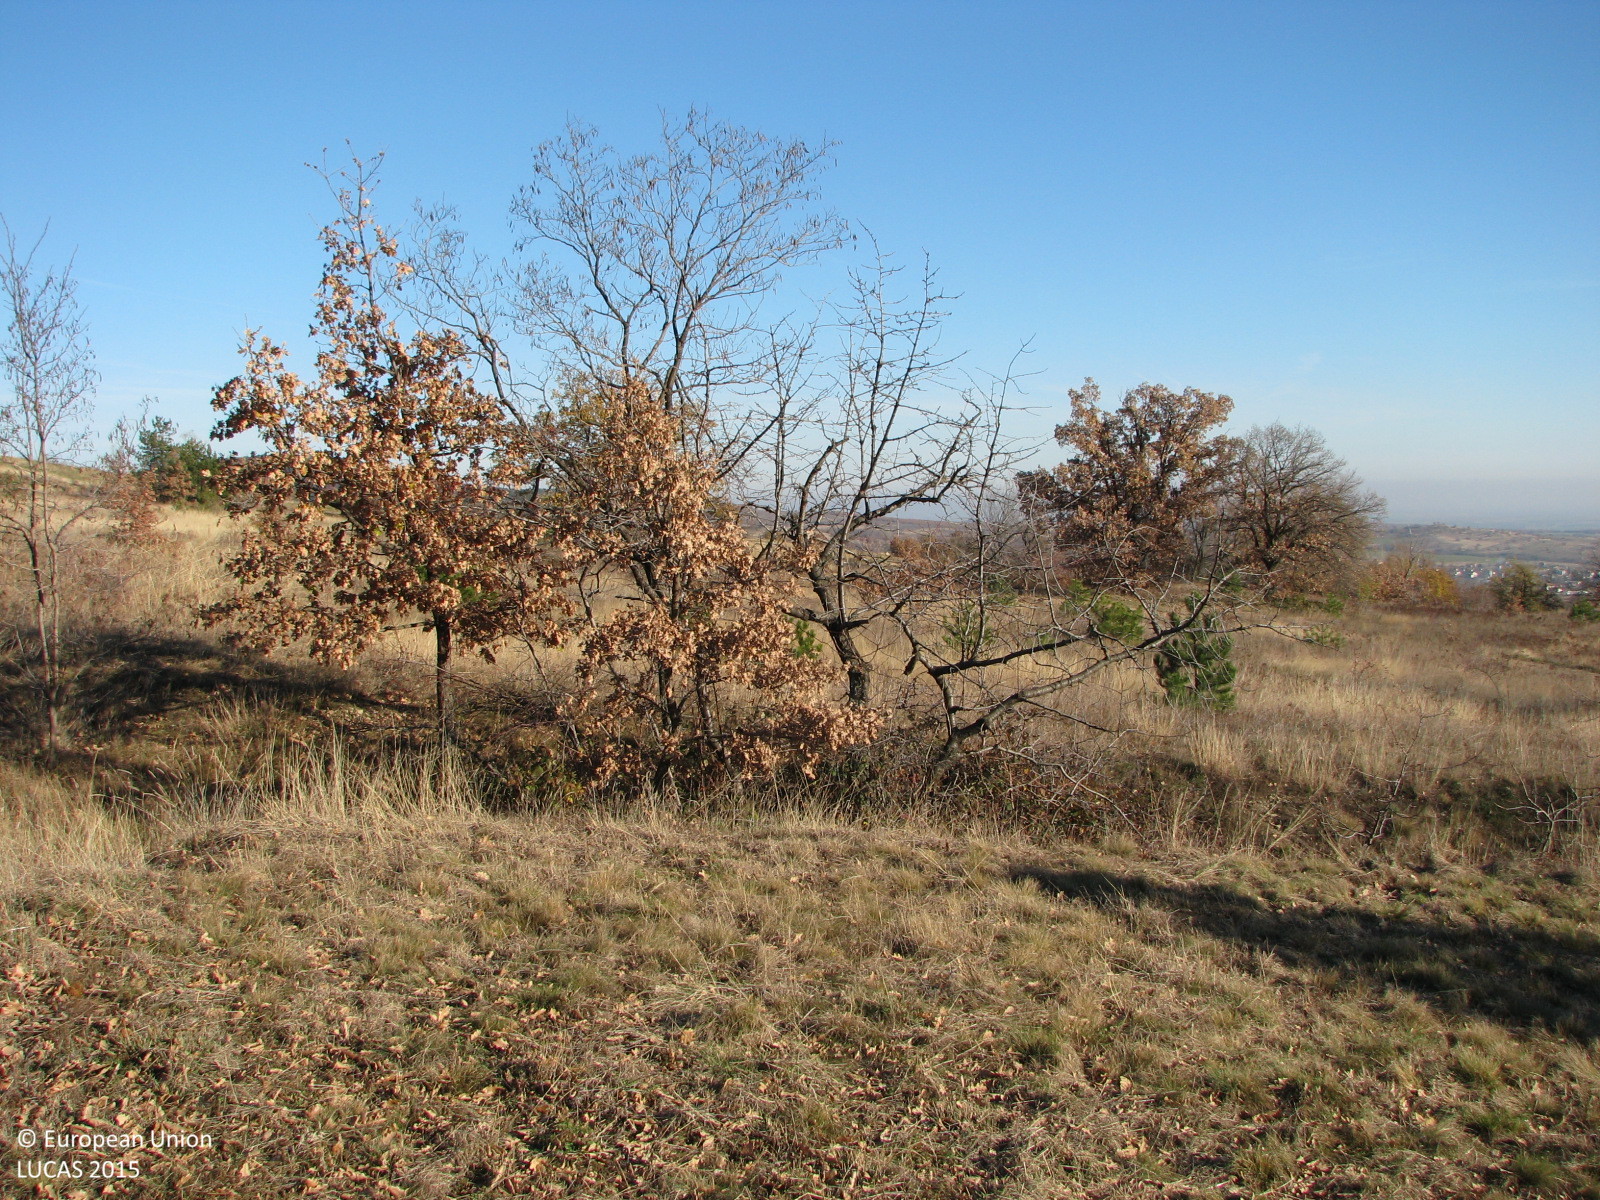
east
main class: Grassland
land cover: Grassland with sparse tree/shrub cover
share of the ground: > 75 %
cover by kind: herbaceous plants 90 %, broadleaved forest trees 5 %, shrubs 5 %
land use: Agriculture (excluding fallow land and kitchen gardens)
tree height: < 5 m
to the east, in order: Ditches and canals; Grassland with sparse tree/shrub cover; Ditches and canals; Grassland with sparse tree/shrub cover; Tracks; Shrubland without tree cover; Grassland without tree/shrub cover
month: December
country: BG
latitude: 42.3809
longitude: 24.1940
